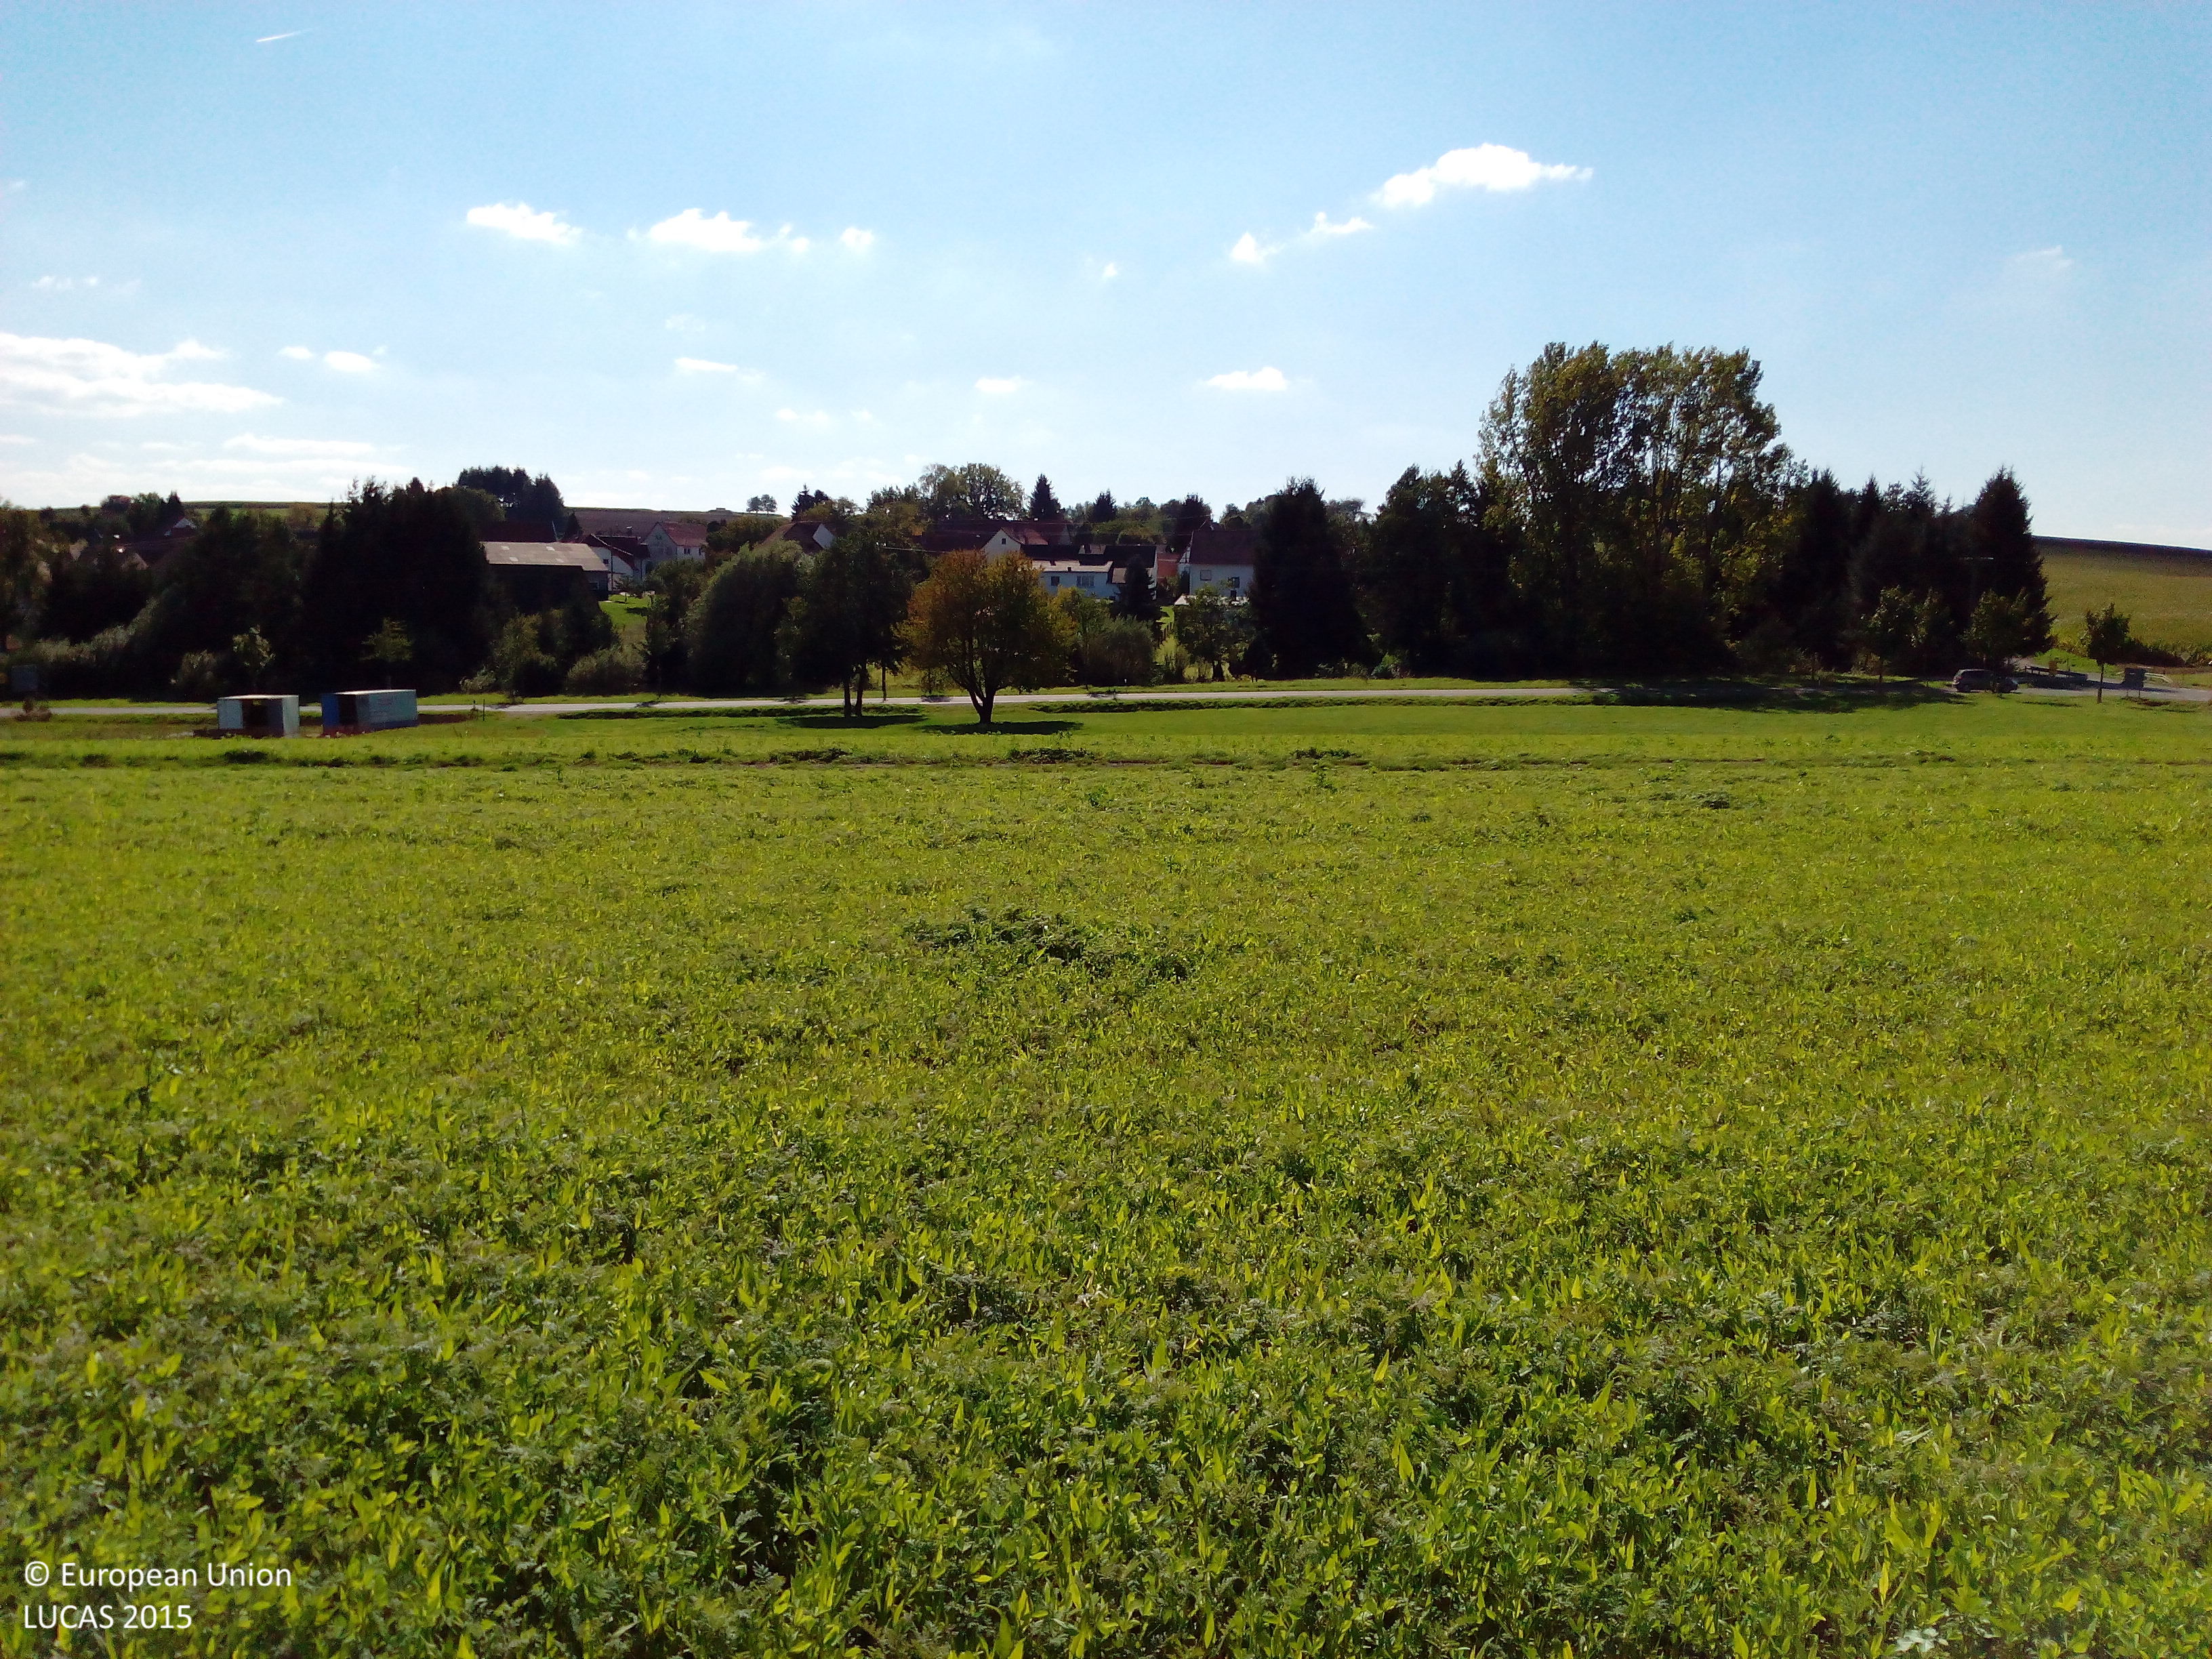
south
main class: Cropland
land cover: Other leguminous and mixtures for fodder
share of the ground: > 75 %
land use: Agriculture (excluding fallow land and kitchen gardens)
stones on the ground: < 10 %
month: September
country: DE
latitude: 50.3257
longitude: 9.2558
